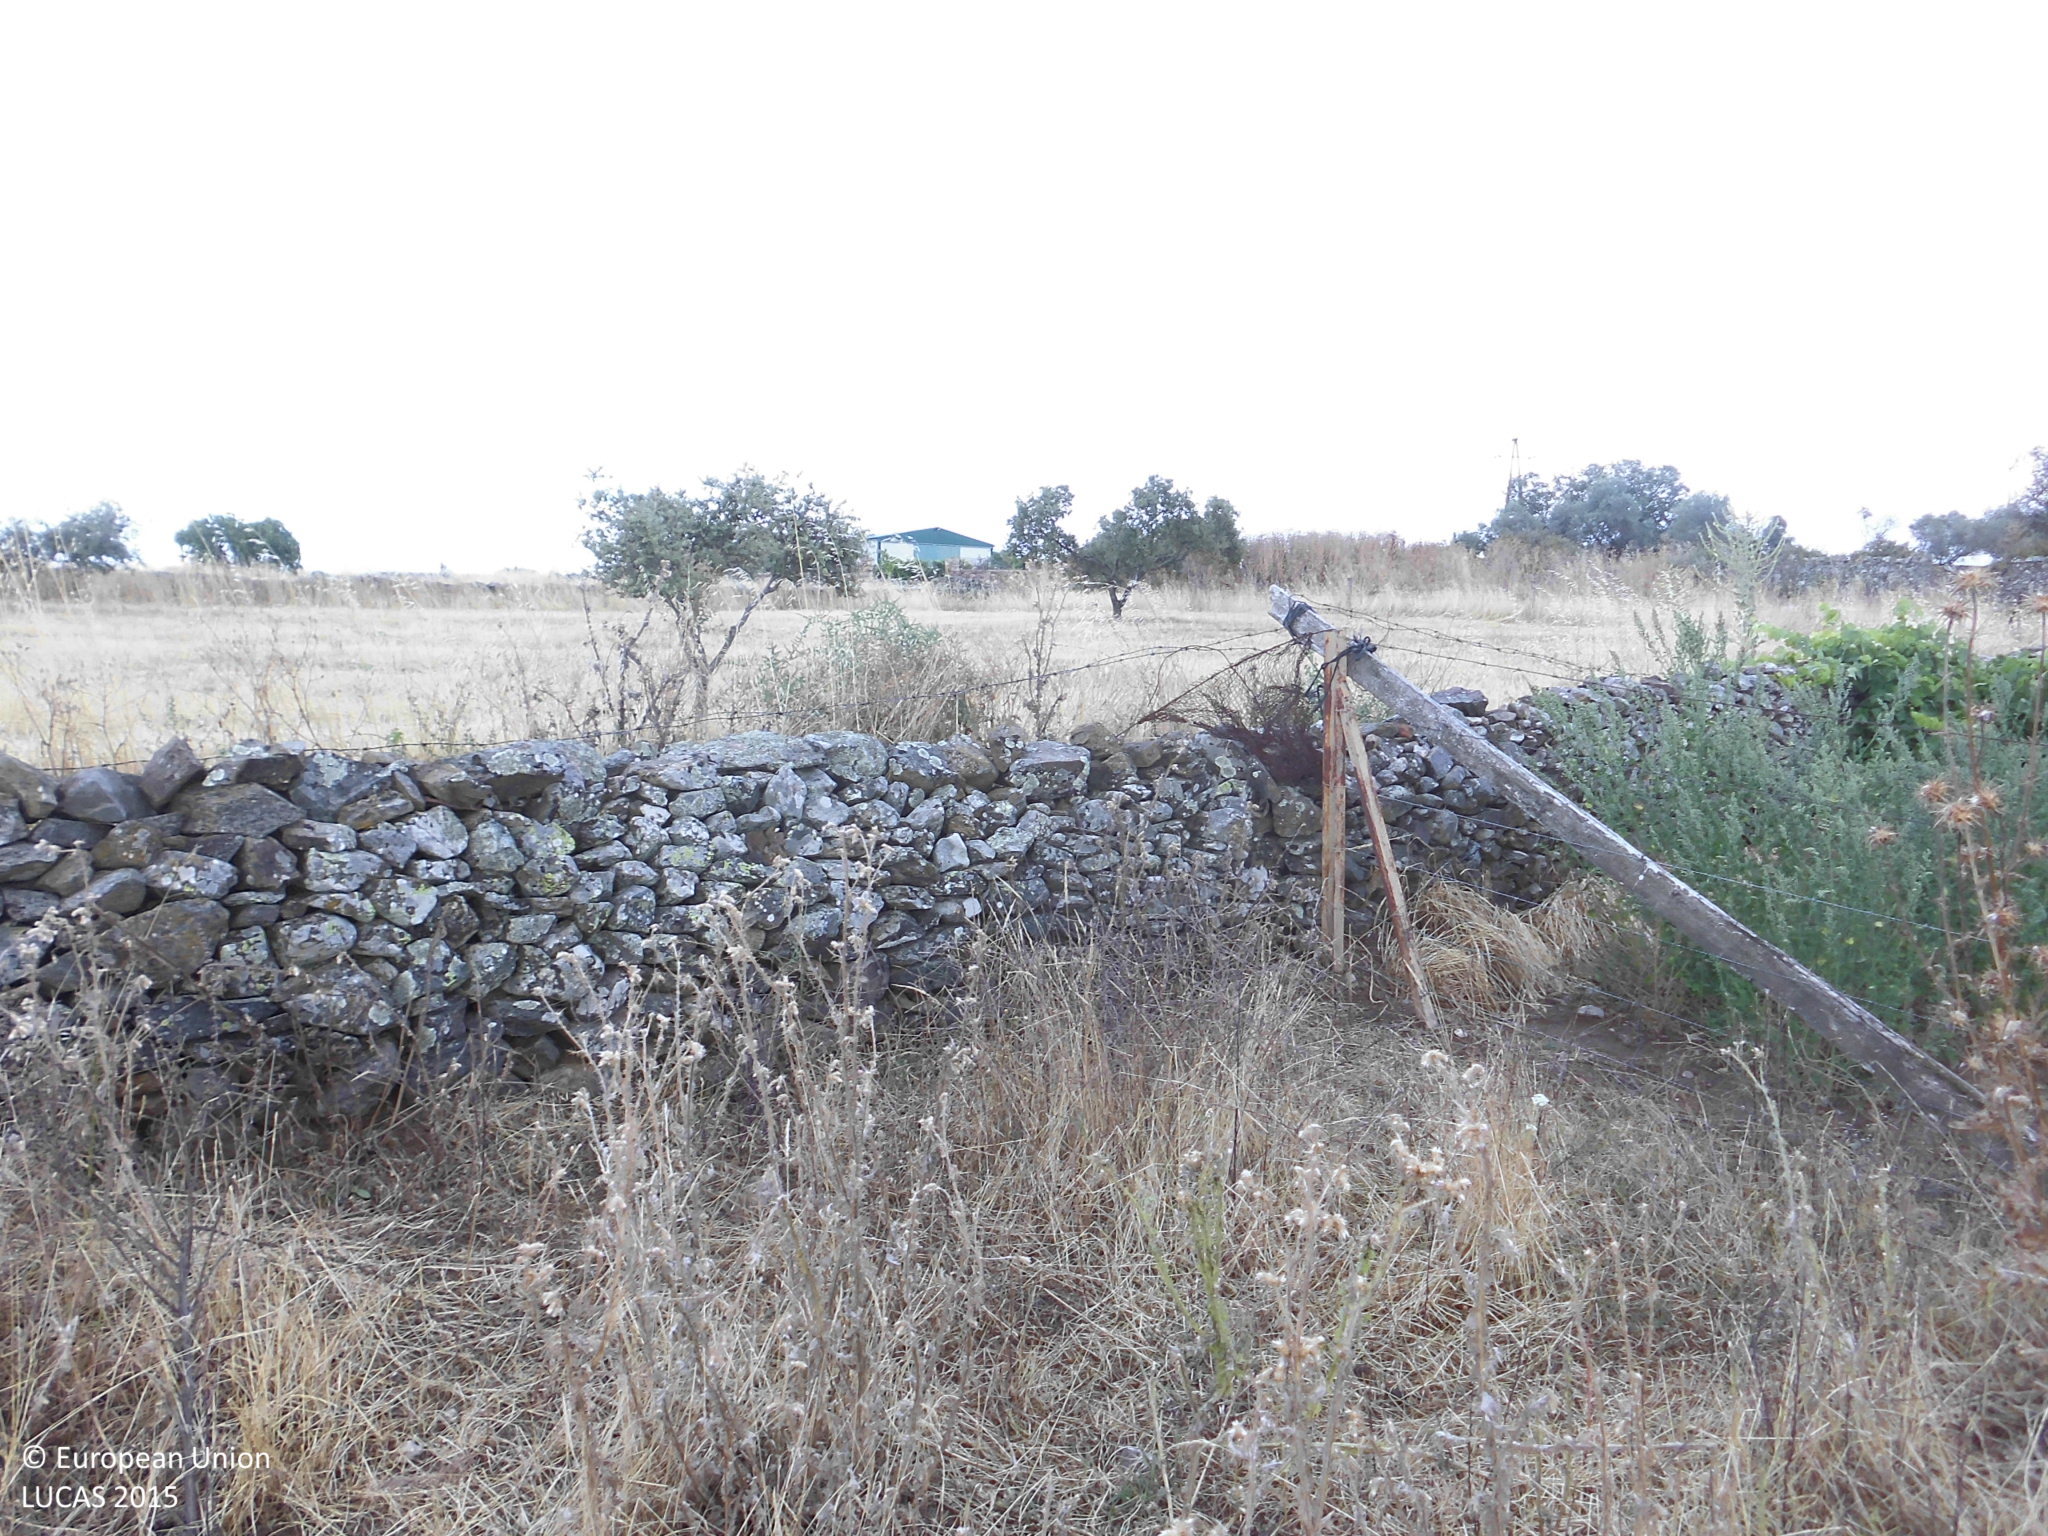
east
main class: Grassland
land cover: Grassland with sparse tree/shrub cover
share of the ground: > 75 %
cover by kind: herbaceous plants 95 %, broadleaved forest trees 5 %
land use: Agriculture (excluding fallow land and kitchen gardens)
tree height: < 5 m
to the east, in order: Grassland with sparse tree/shrub cover; Dry stone walls; Grassland with sparse tree/shrub cover; Dry stone walls; Grassland with sparse tree/shrub cover; Dry stone walls; Tracks; Dry stone walls; Grassland without tree/shrub cover; Paved roads, cycling and walking lanes; Fences; Grassland without tree/shrub cover; Other bare soil; Other fruit trees and berries; Dry stone walls; Olive groves; Dry stone walls; Grassland with sparse tree/shrub cover
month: June
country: ES
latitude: 39.3270
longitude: -5.9141
